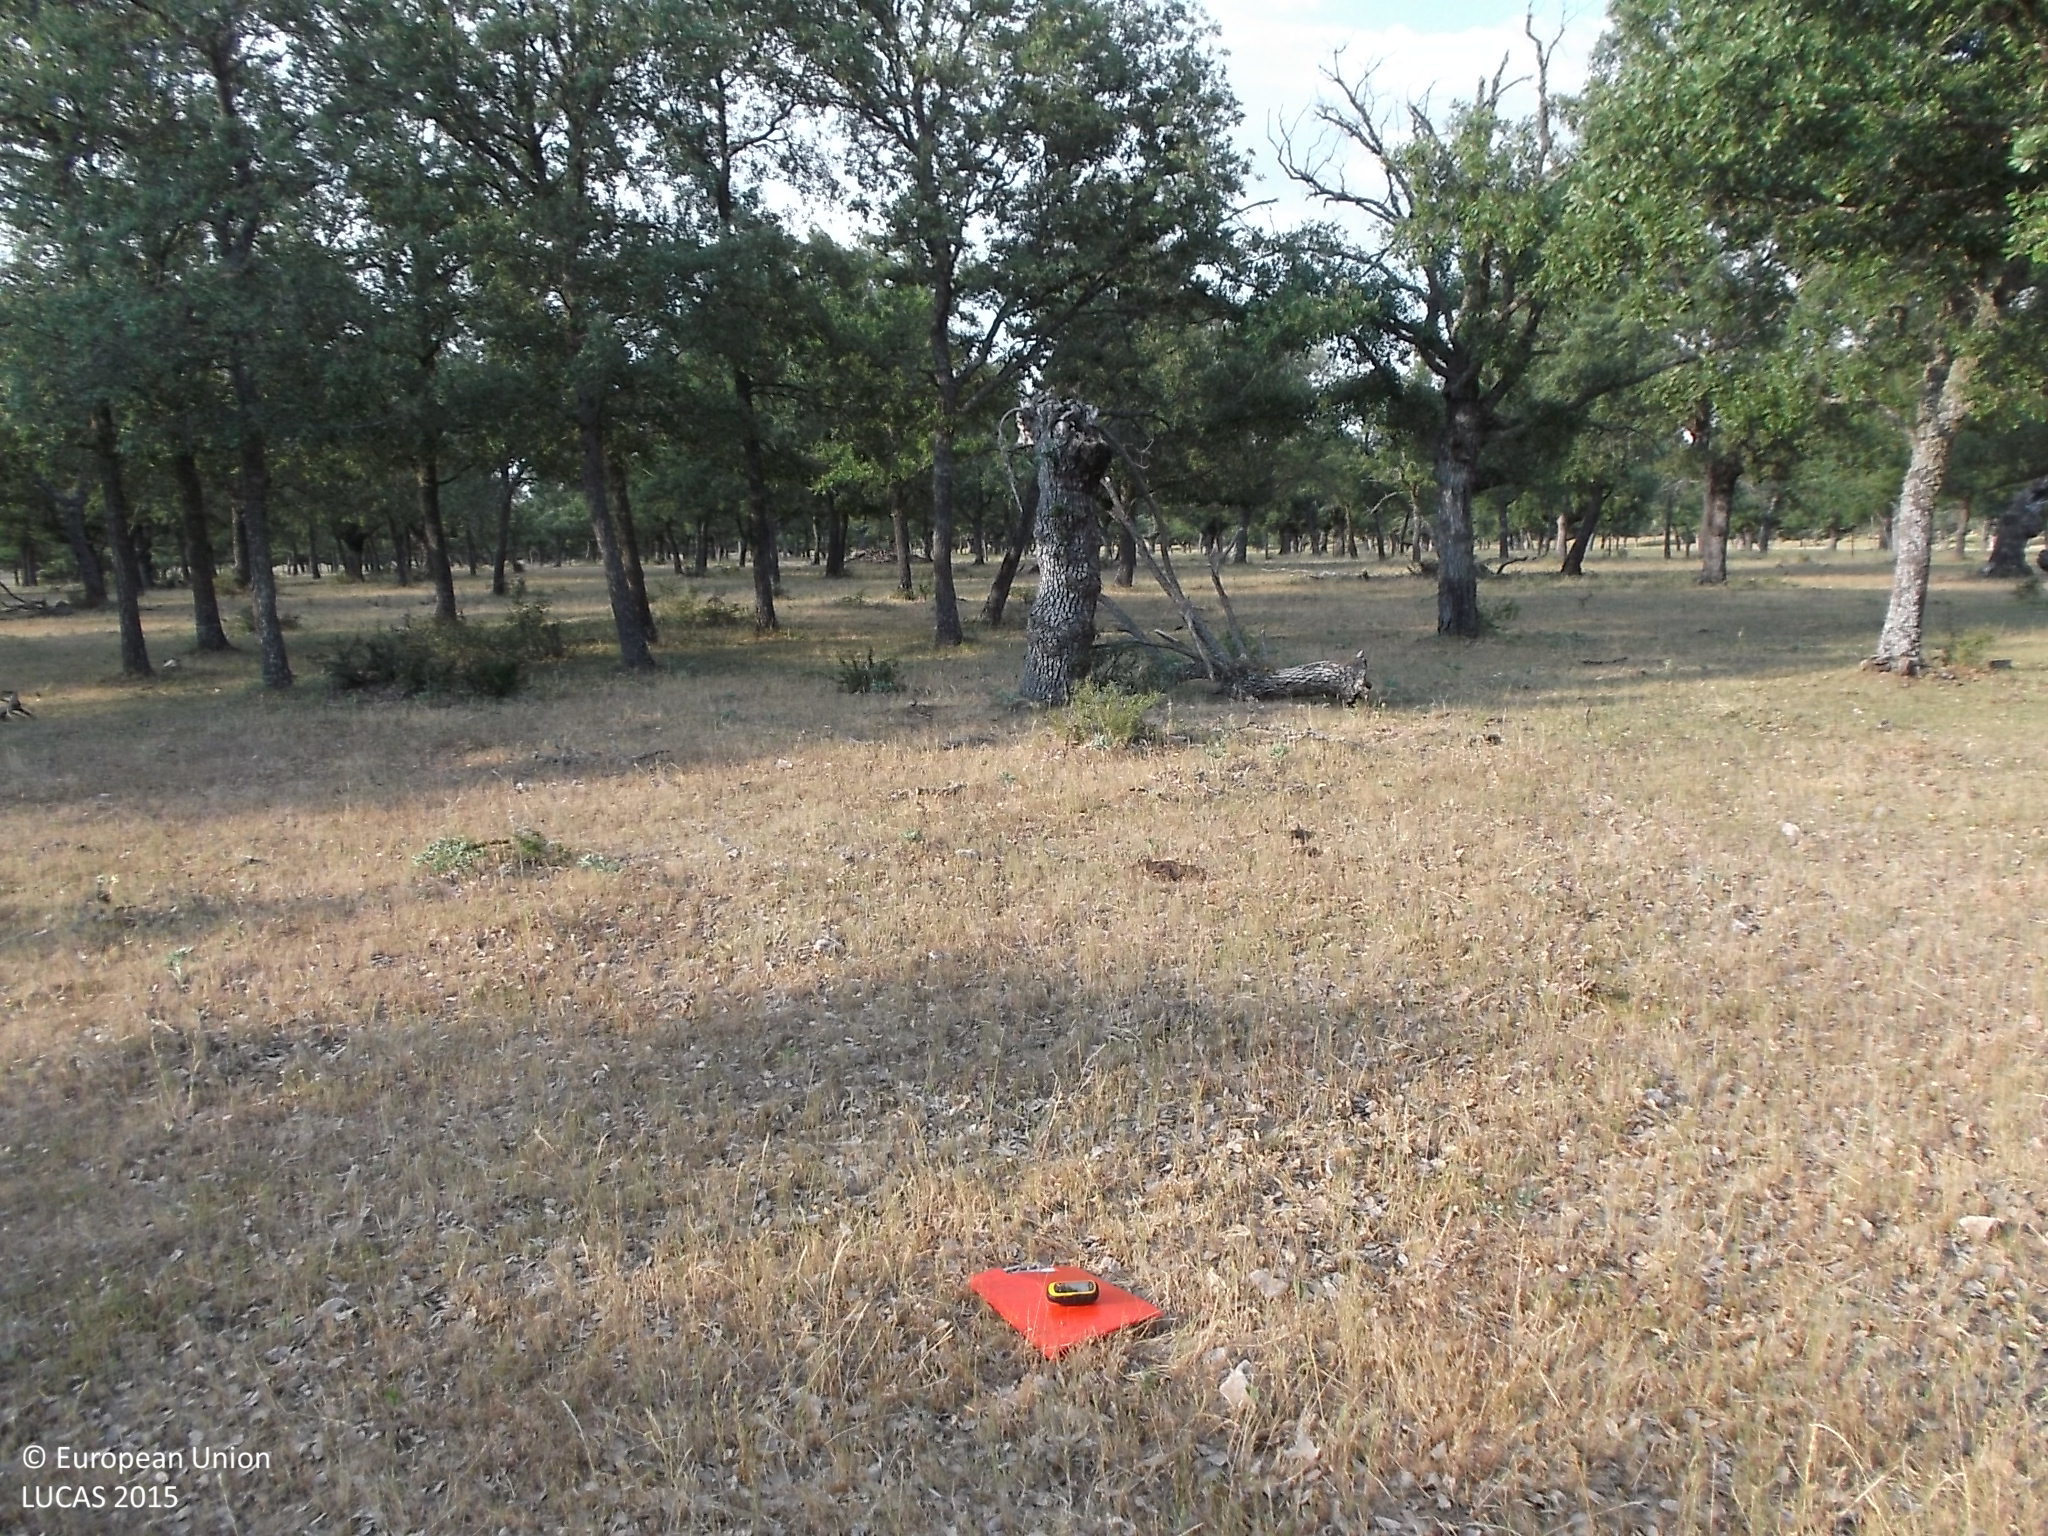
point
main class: Woodland
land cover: Broadleaved woodland
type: thermophilous deciduous forest
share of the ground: 25 - 50 %
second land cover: Grassland without tree/shrub cover
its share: 50 - 75 %
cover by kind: herbaceous plants 60 %, broadleaved forest trees 40 %
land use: Forestry
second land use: Agriculture (excluding fallow land and kitchen gardens)
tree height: > 5 m
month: June
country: ES
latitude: 40.8545
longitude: -6.3532
